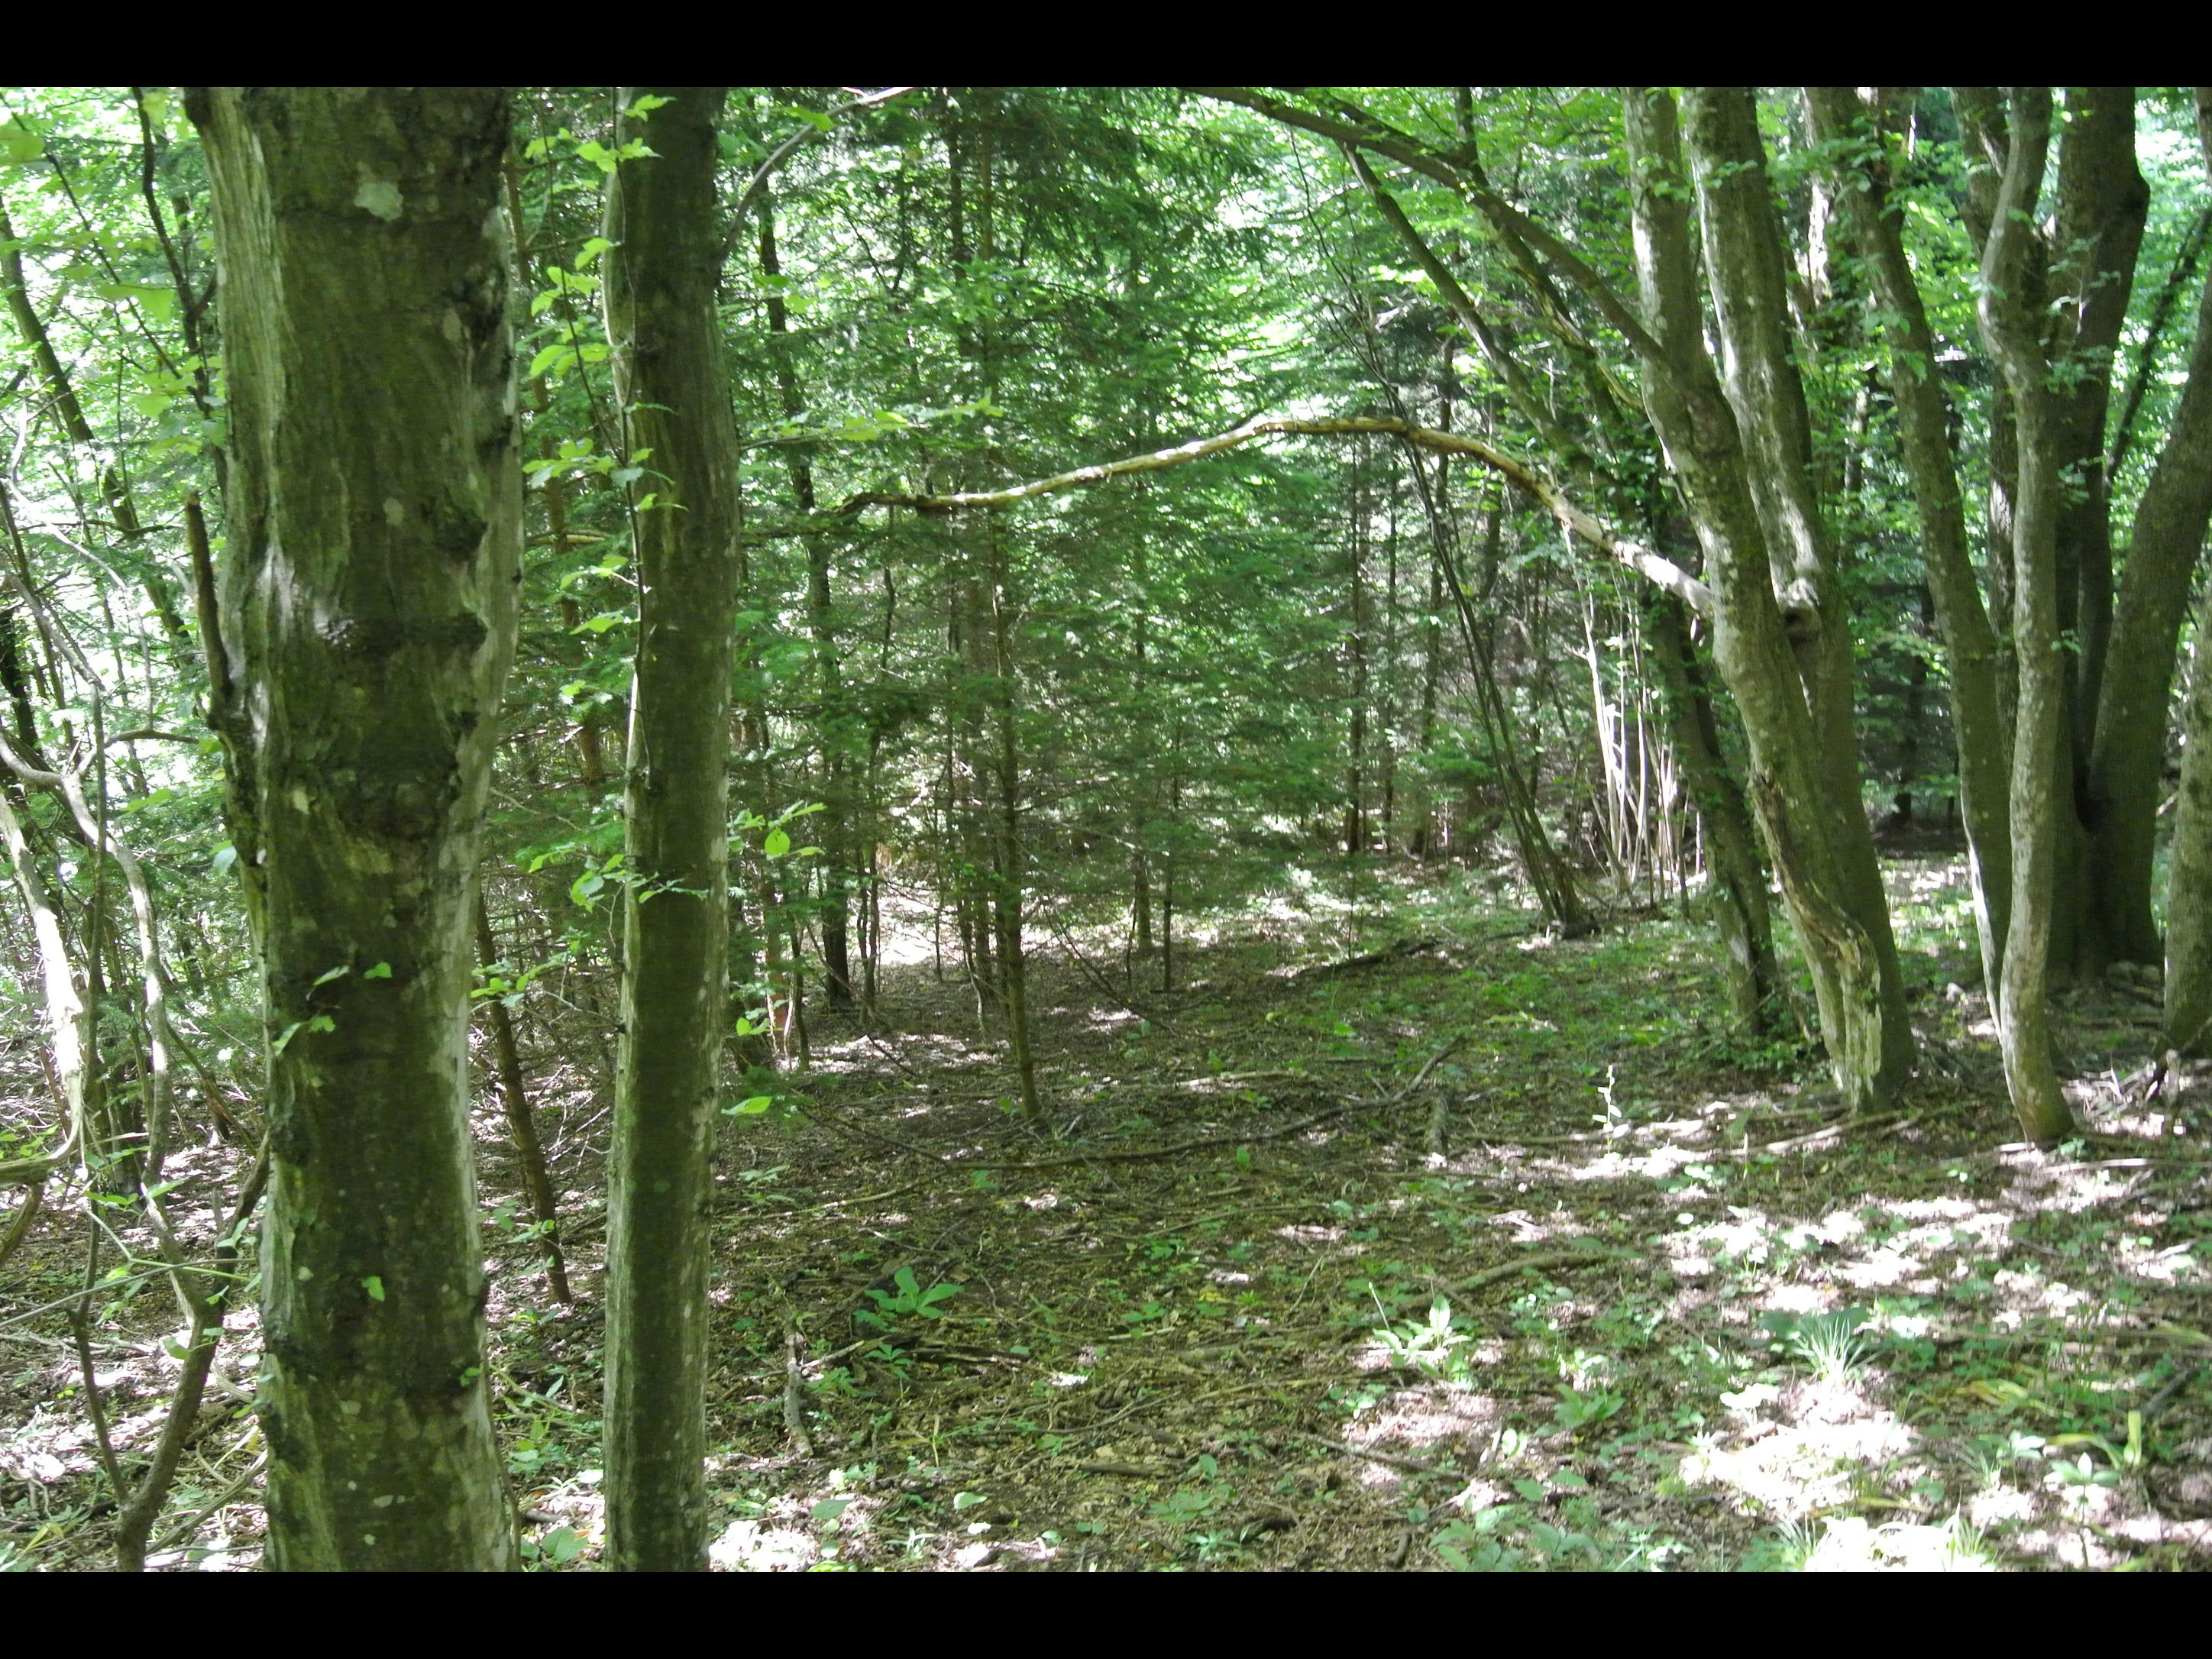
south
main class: Woodland
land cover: Spruce dominated mixed woodland
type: mountainous beech forest
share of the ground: > 75 %
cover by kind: broadleaved forest trees 65 %, coniferous forest trees 35 %
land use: Forestry
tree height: > 5 m
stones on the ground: < 10 %
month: June
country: AT
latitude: 47.9471
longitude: 15.3973
